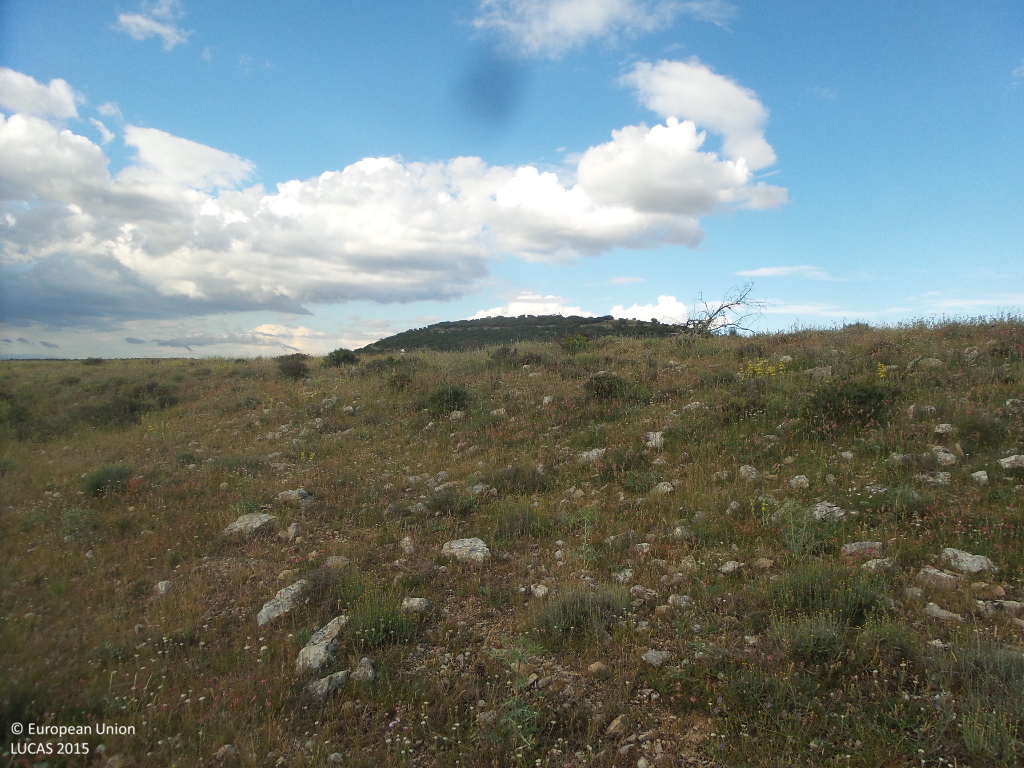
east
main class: Shrubland
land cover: Shrubland without tree cover
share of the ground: 25 - 50 %
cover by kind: shrubs 40 %, herbaceous plants 40 %, unconsolidated bare surface 20 %
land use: Semi-natural and natural areas not in use
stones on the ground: 10 - 25 %
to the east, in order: Shrubland without tree cover; Durum wheat; Tracks; Shrubland without tree cover
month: June
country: ES
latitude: 41.3721
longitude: -3.0124
